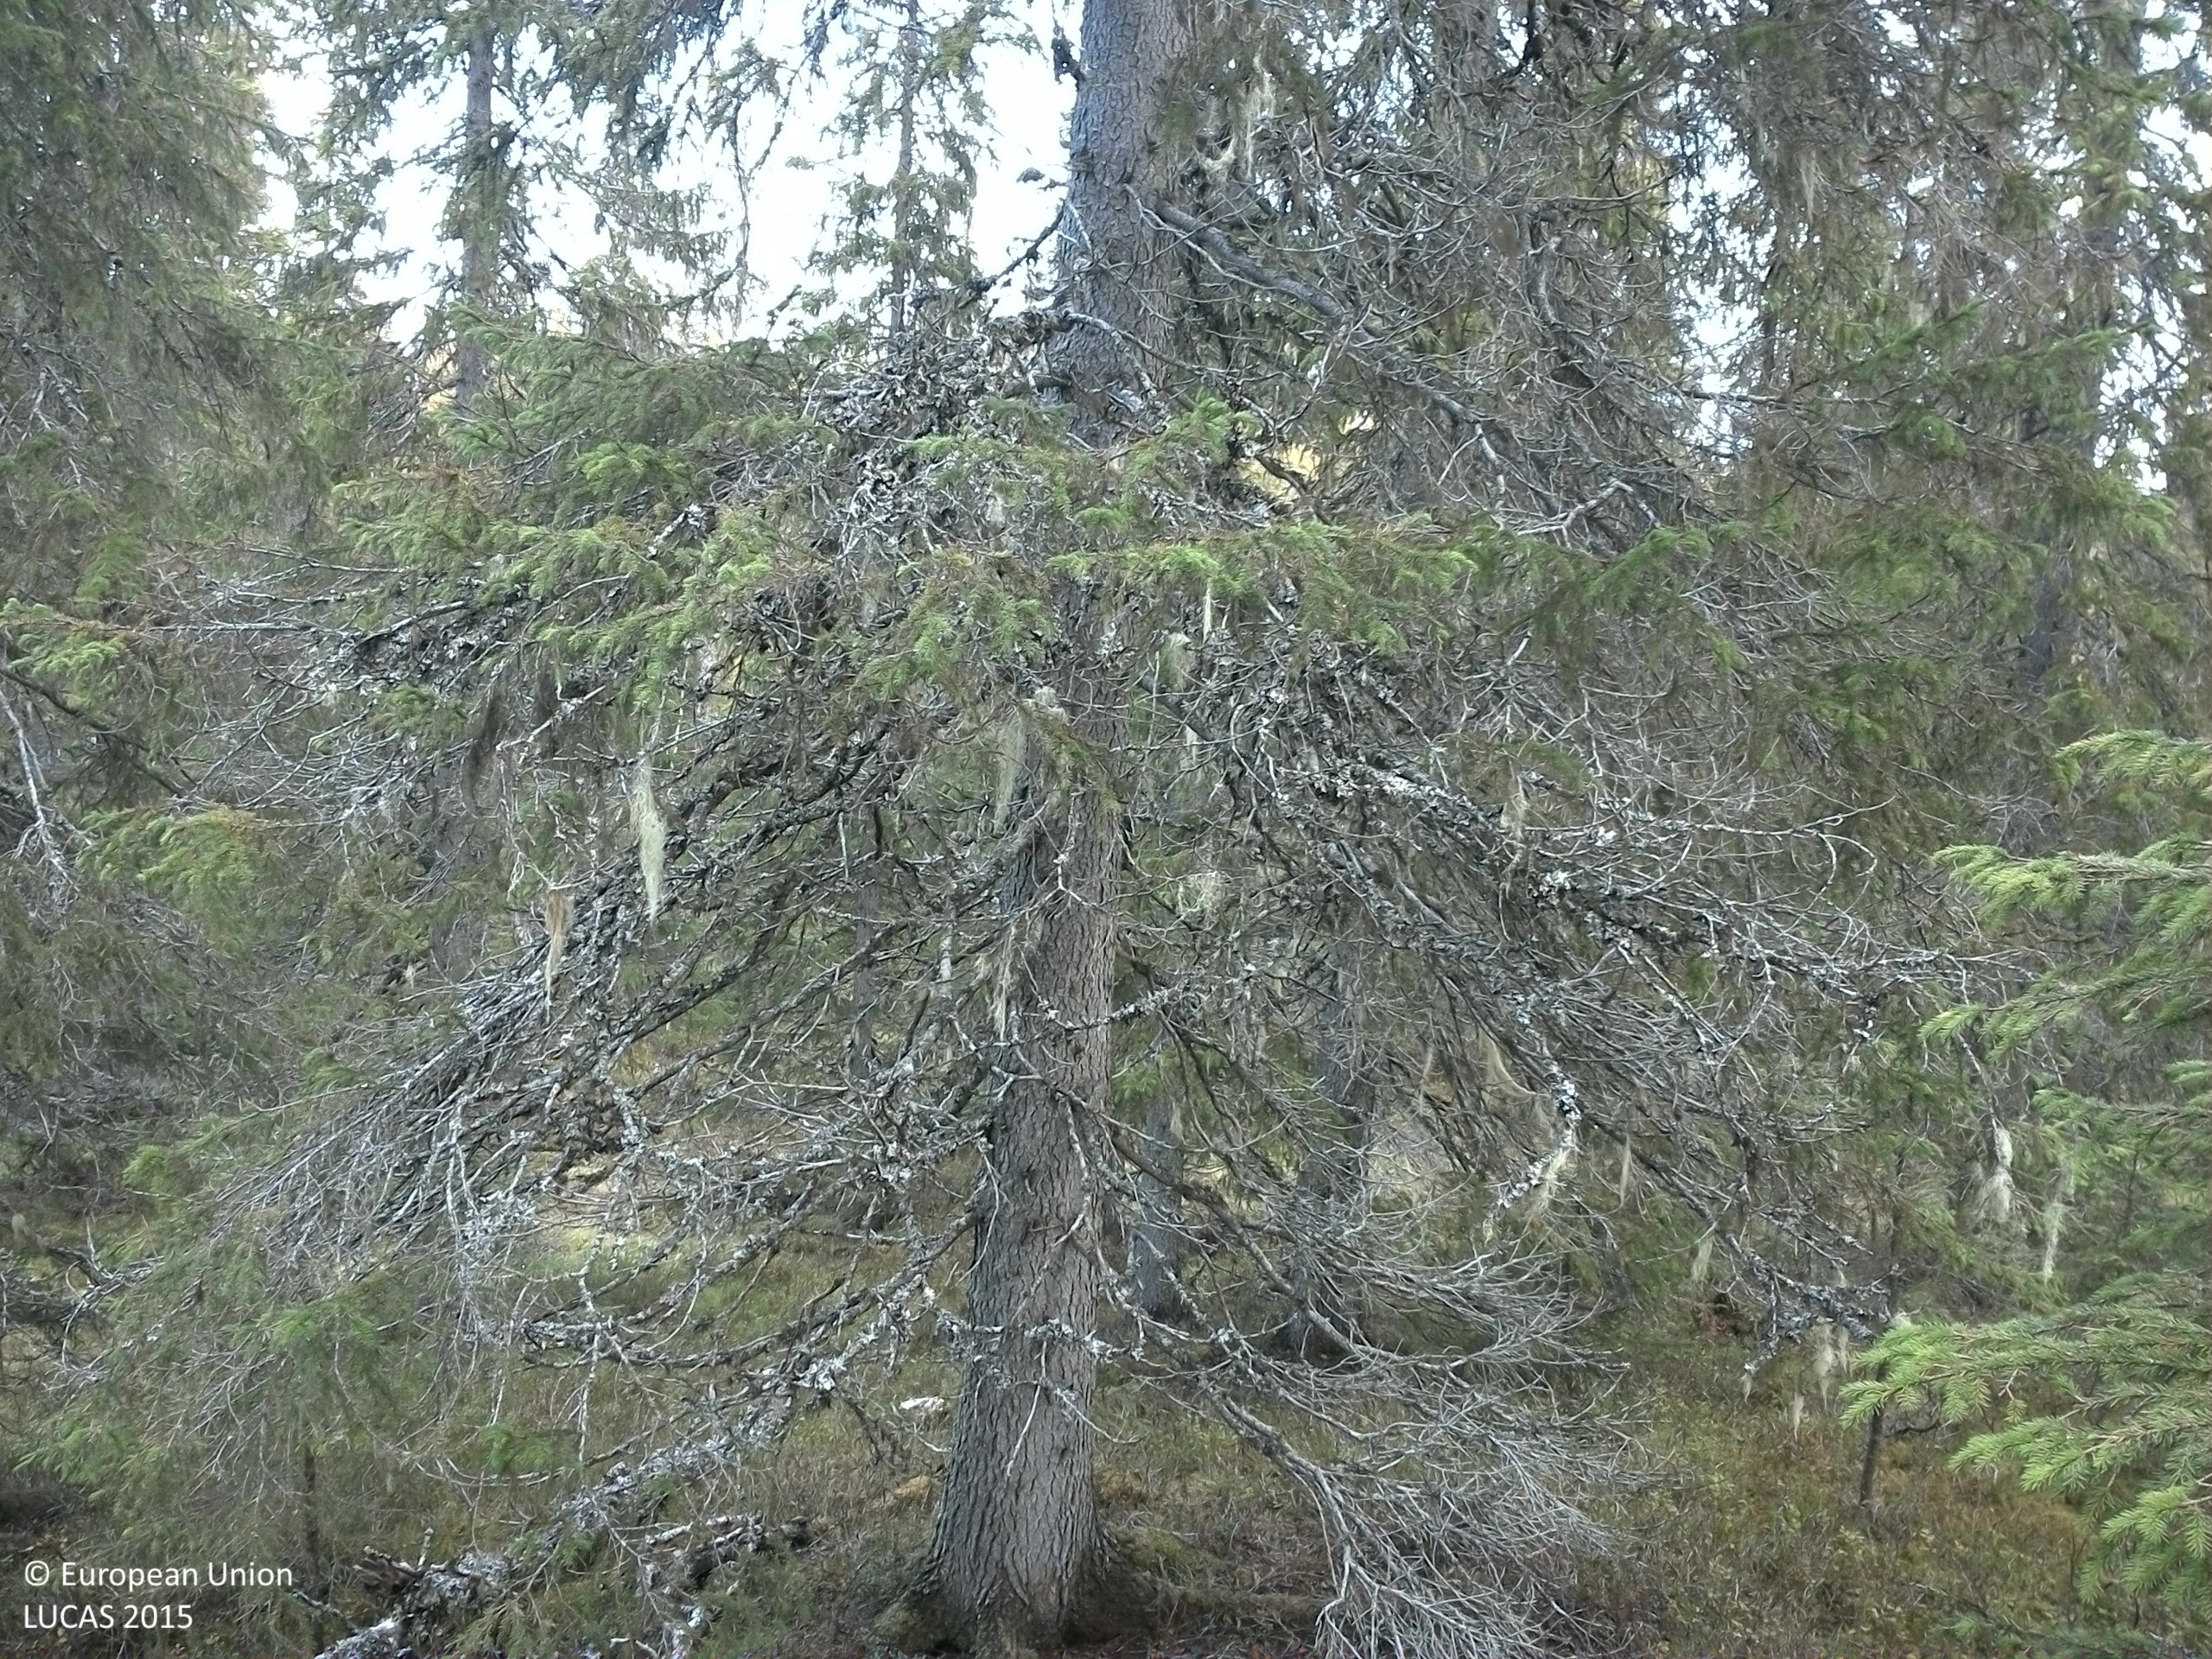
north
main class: Woodland
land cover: Spruce dominated coniferous woodland
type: boreal forest
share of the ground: 25 - 50 %
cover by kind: coniferous forest trees 40 %, shrubs 40 %, lichens and mosses 15 %, broadleaved forest trees 5 %
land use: Forestry
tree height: > 5 m
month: October
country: SE
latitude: 64.6196
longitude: 13.9694
